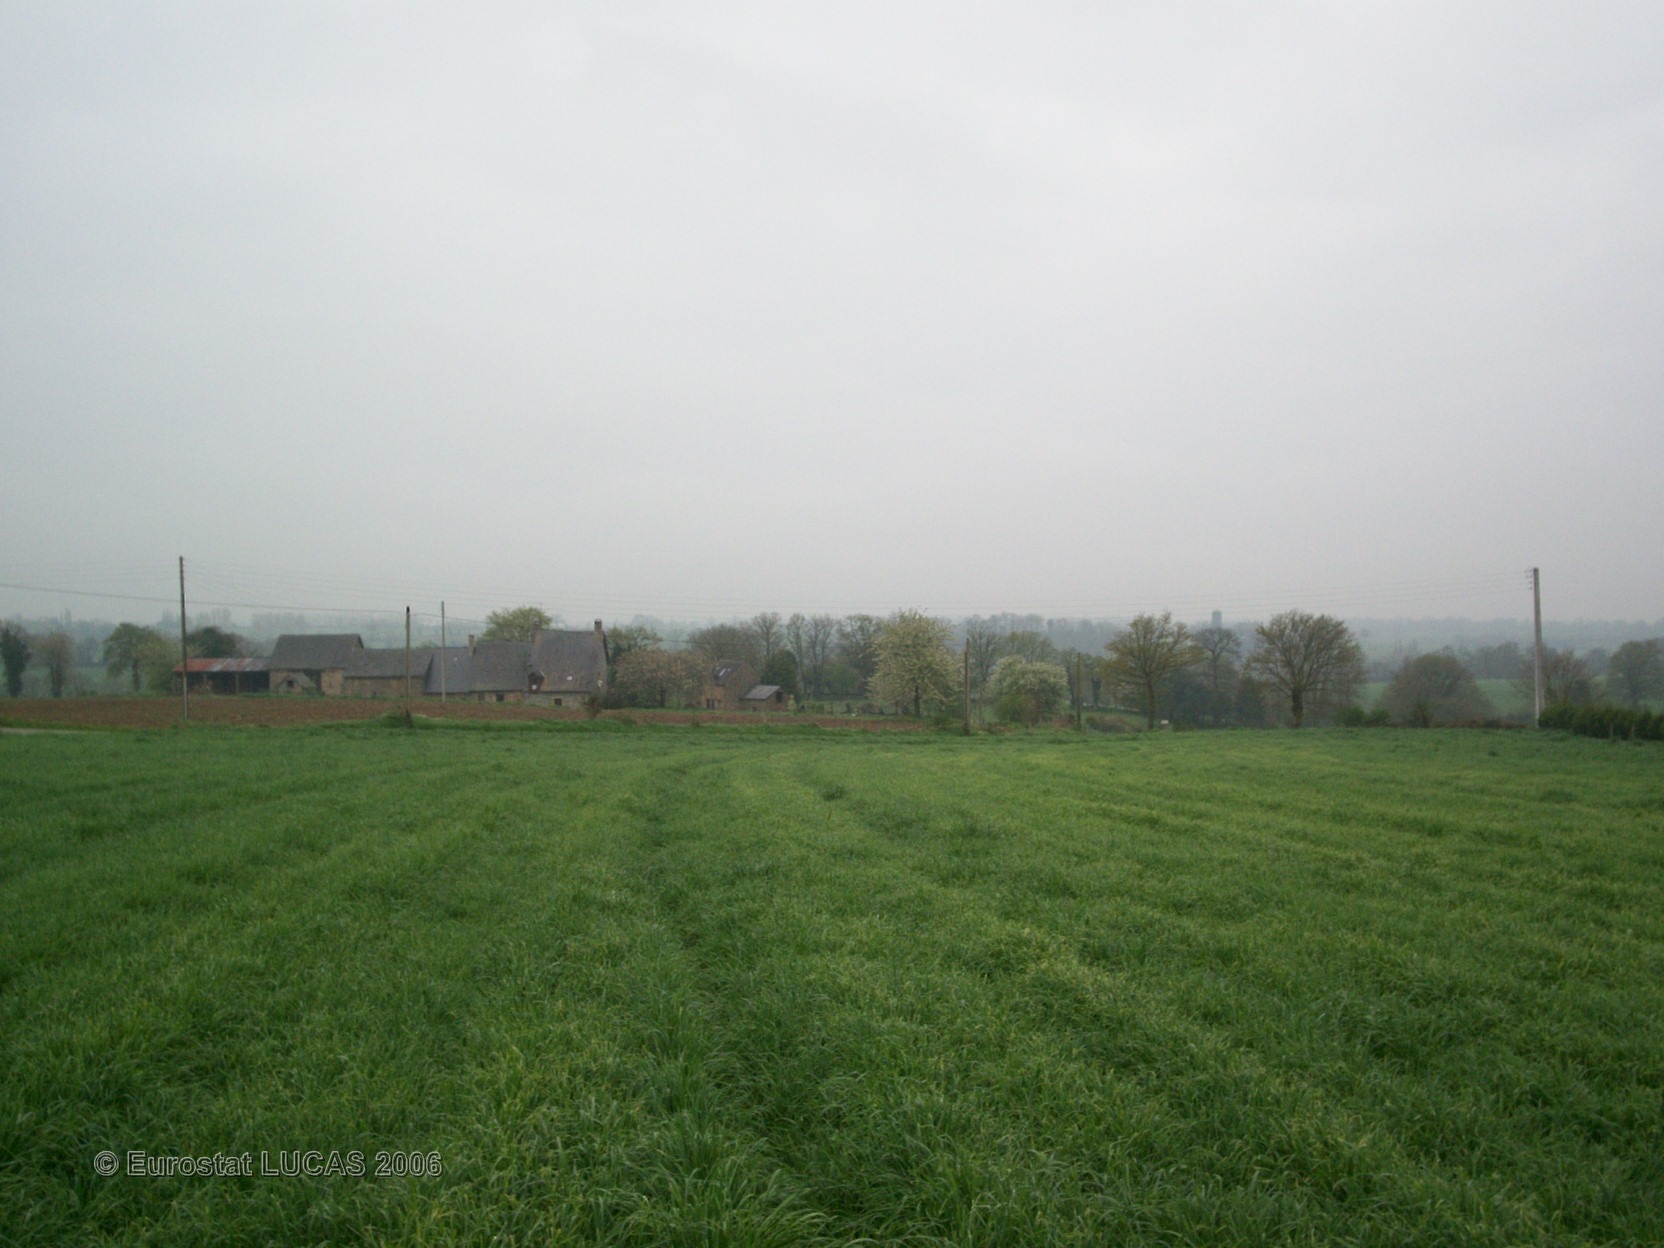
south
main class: Grassland
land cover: Grassland without tree/shrub cover
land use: Agriculture (excluding fallow land and kitchen gardens)
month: April
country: FR
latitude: 48.2494
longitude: -0.6617
